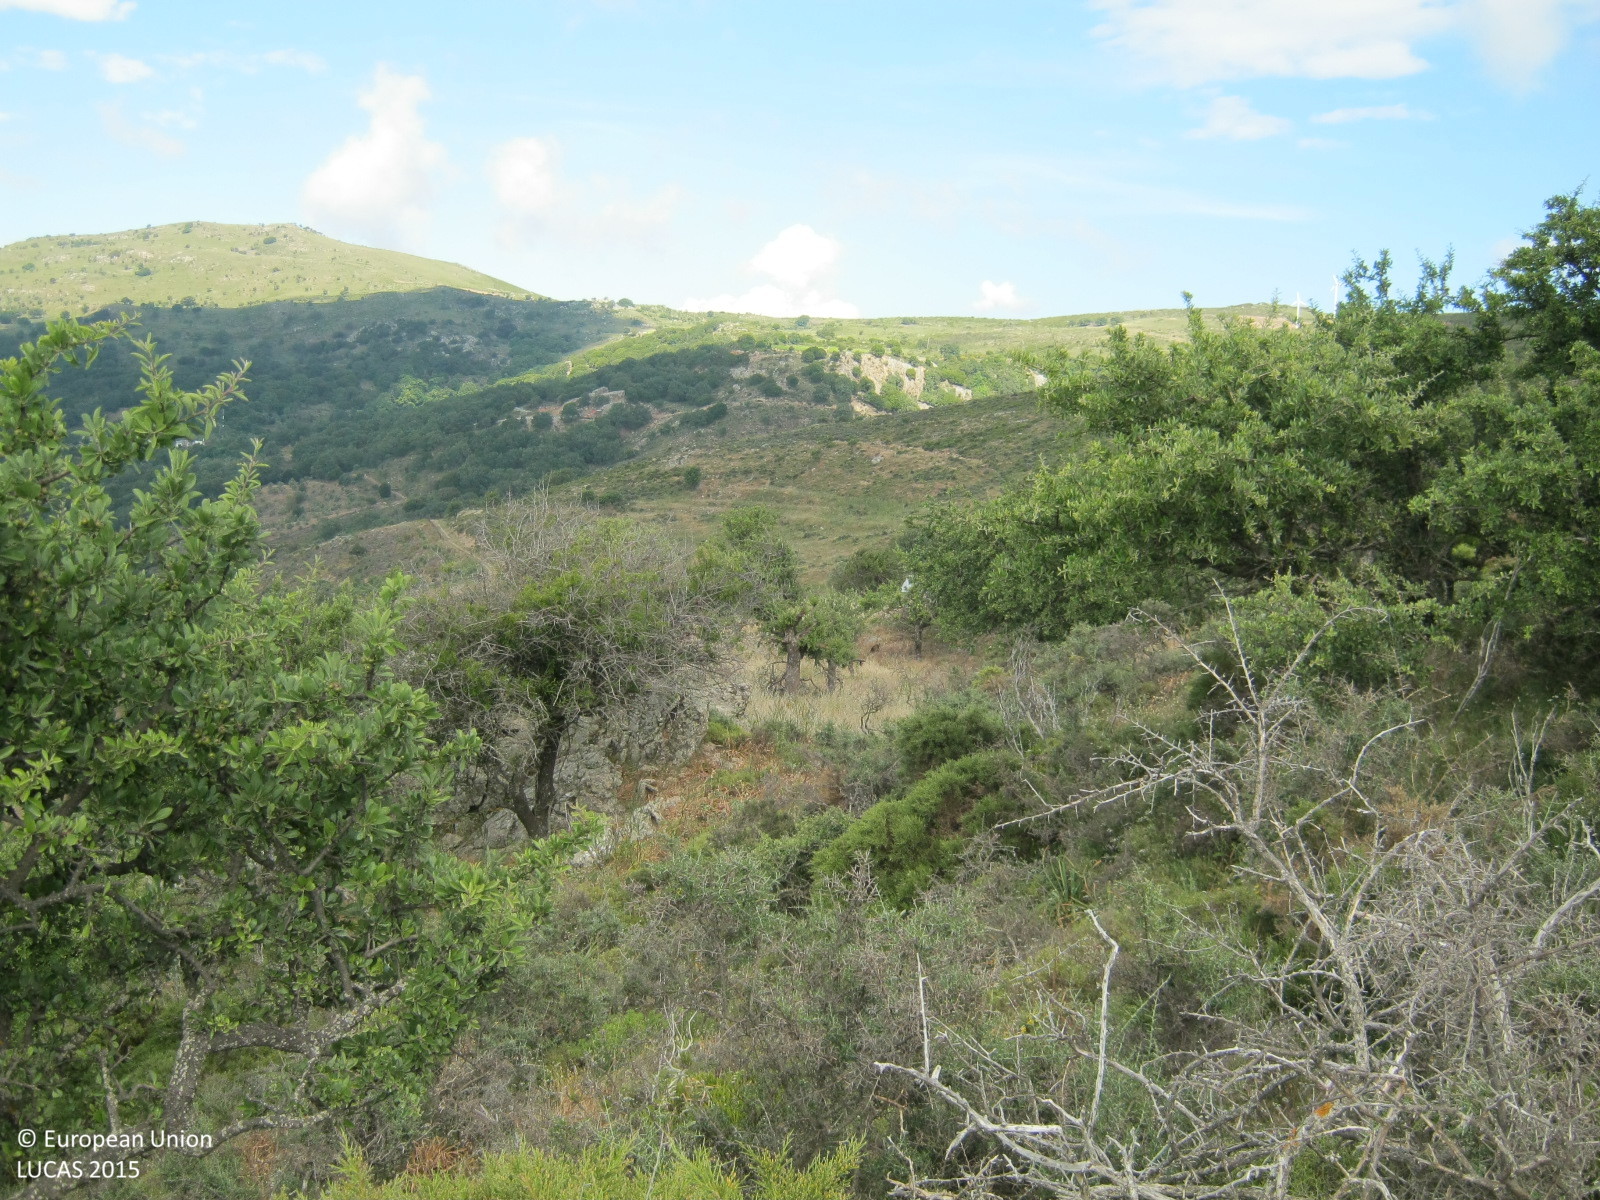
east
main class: Shrubland
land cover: Shrubland with sparse tree cover
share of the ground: > 75 %
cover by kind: shrubs 70 %, unconsolidated bare surface 15 %, herbaceous plants 10 %, broadleaved forest trees 5 %
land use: Agriculture (excluding fallow land and kitchen gardens)
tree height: < 5 m
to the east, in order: Shrubland with sparse tree cover; Other mixed woodland; Fences; Tracks; Fences; Shrubland without tree cover
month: June
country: GR
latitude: 35.3111
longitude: 23.7393
